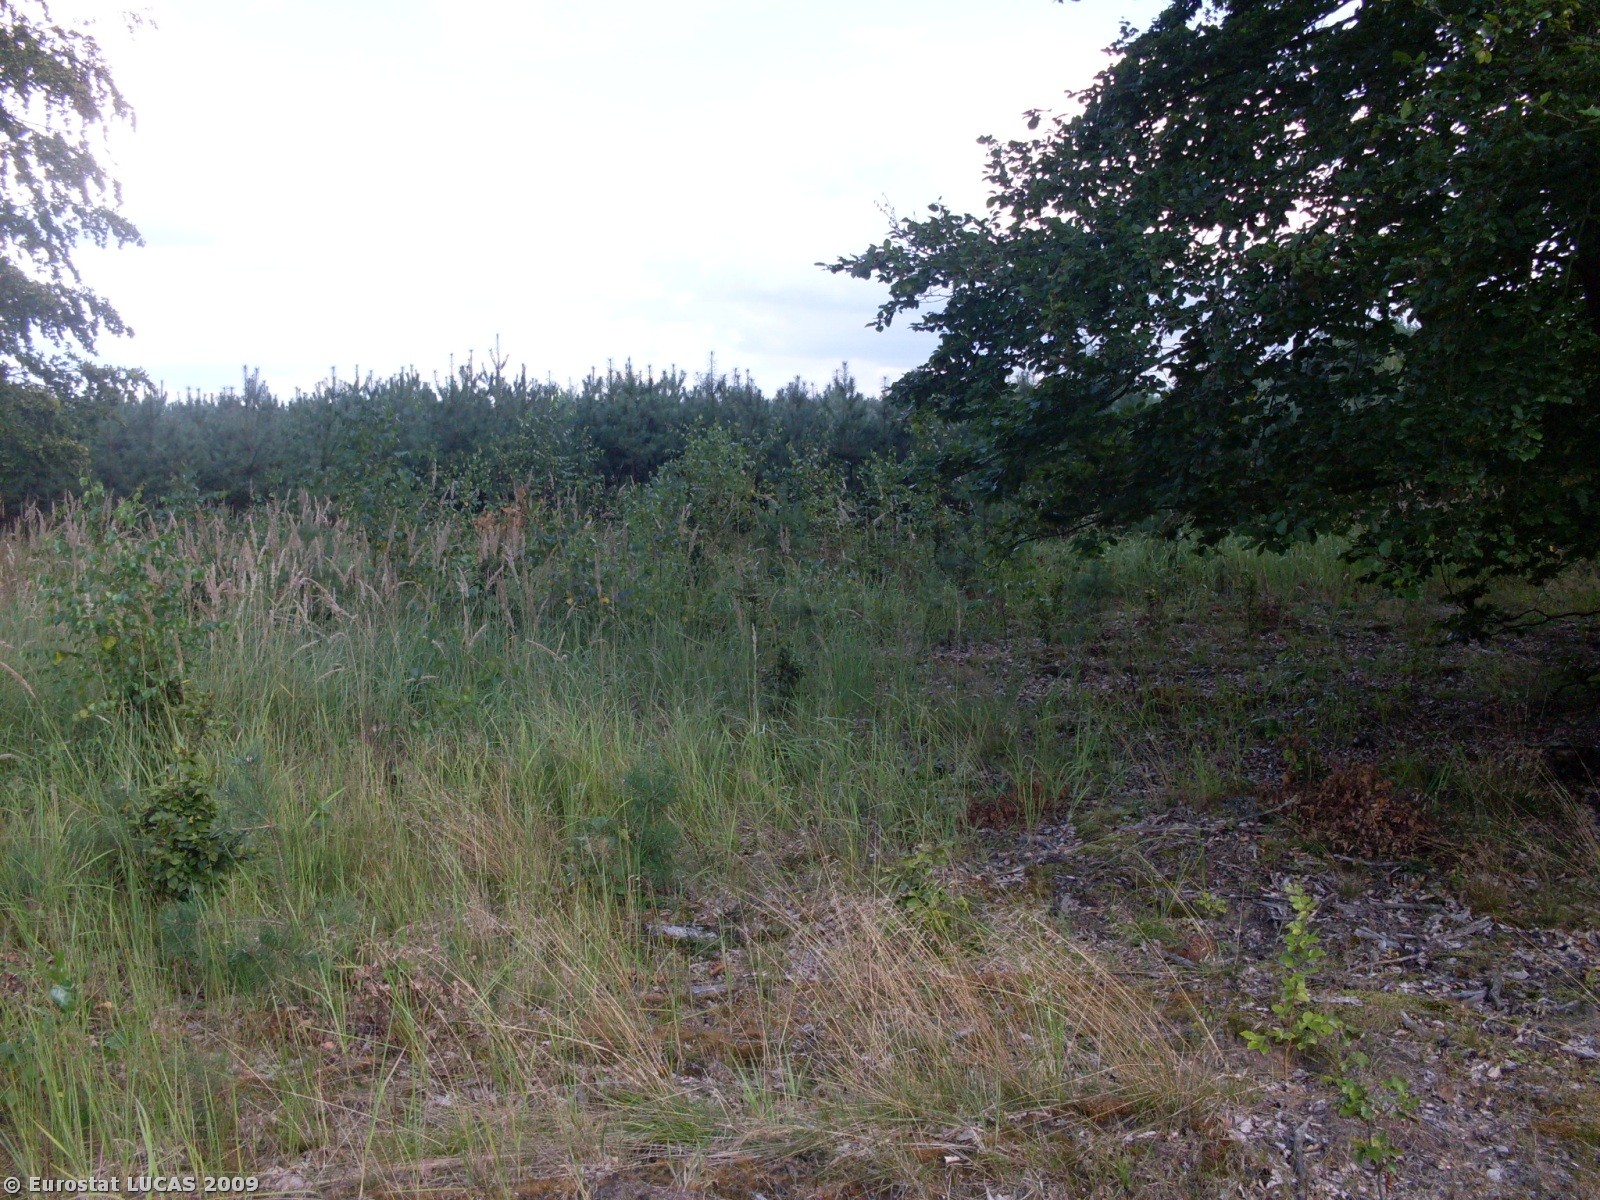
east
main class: Woodland
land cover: Mixed woodland
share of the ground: 10 - 25 %
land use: Forestry
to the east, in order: Mixed woodland; Coniferous woodland; Grassland with sparse tree/shrub cover
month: August
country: PL
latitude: 52.9019
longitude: 15.4299
